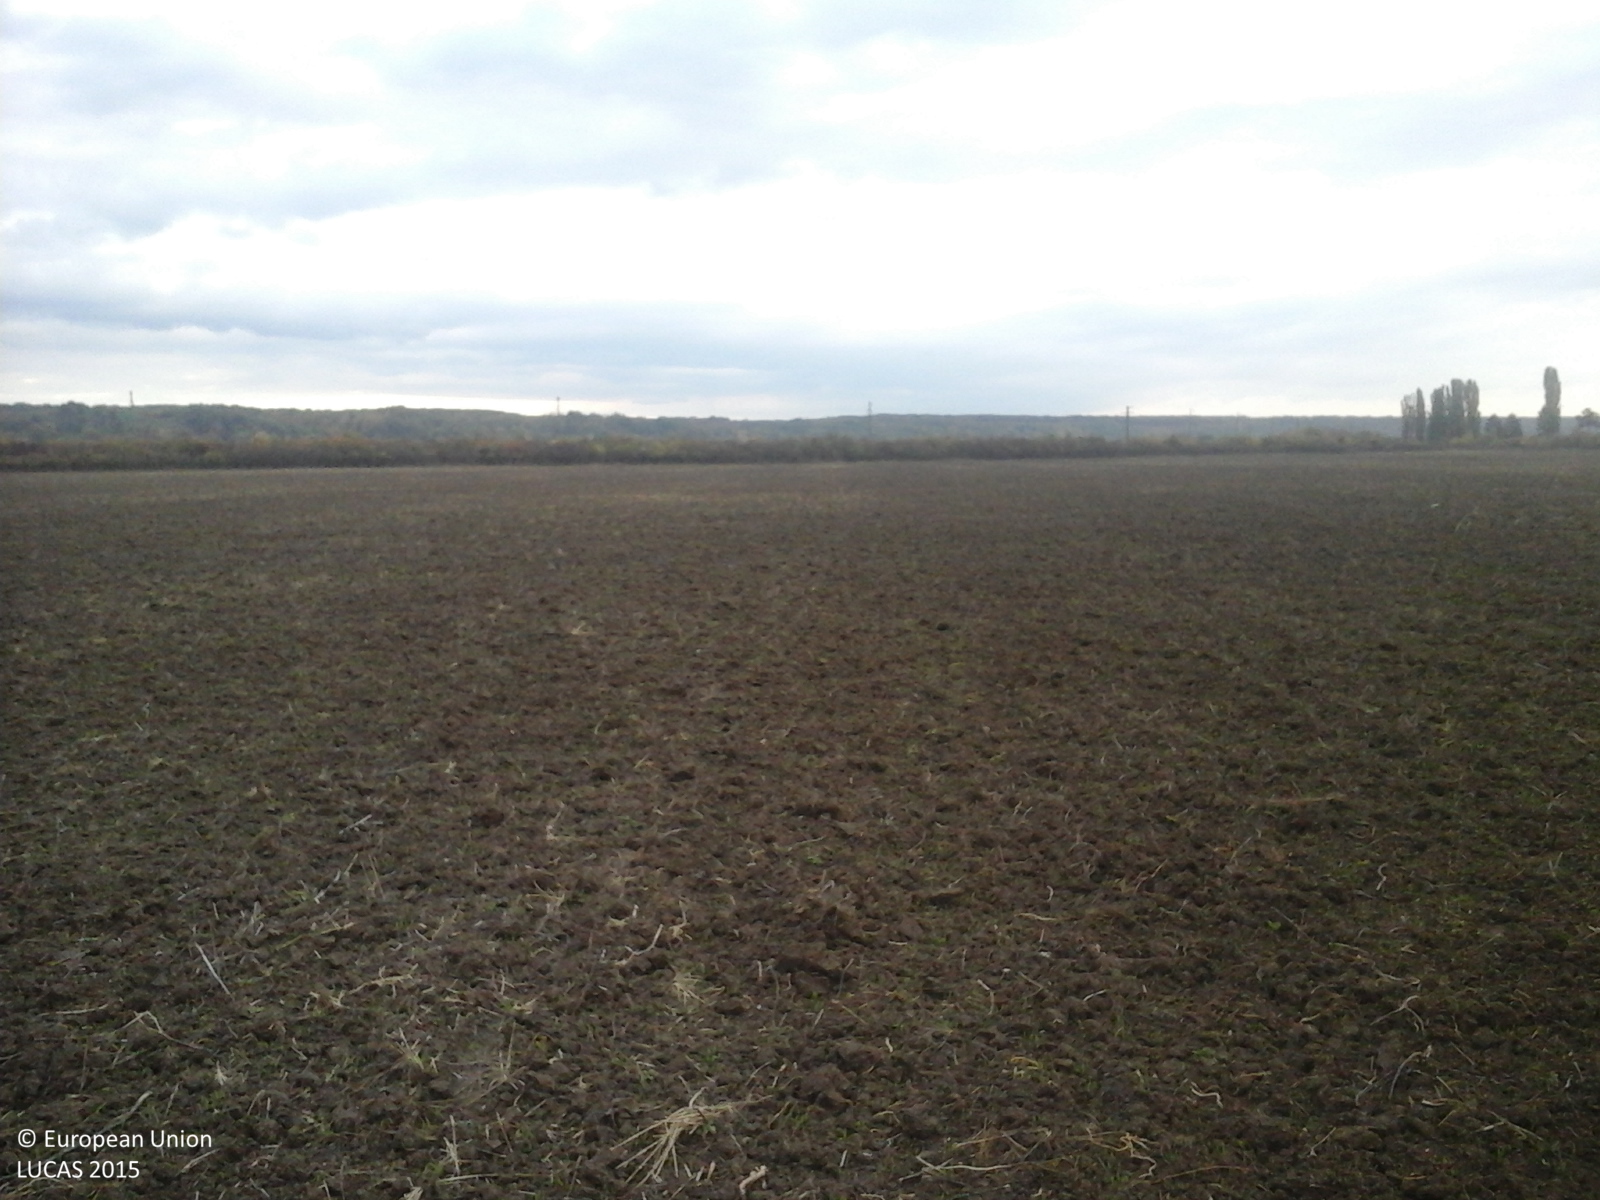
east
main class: Cropland
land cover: Common wheat
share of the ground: < 10 %
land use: Agriculture (excluding fallow land and kitchen gardens)
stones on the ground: < 10 %
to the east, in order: Common wheat
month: October
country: RO
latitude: 44.9239
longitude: 25.5922
